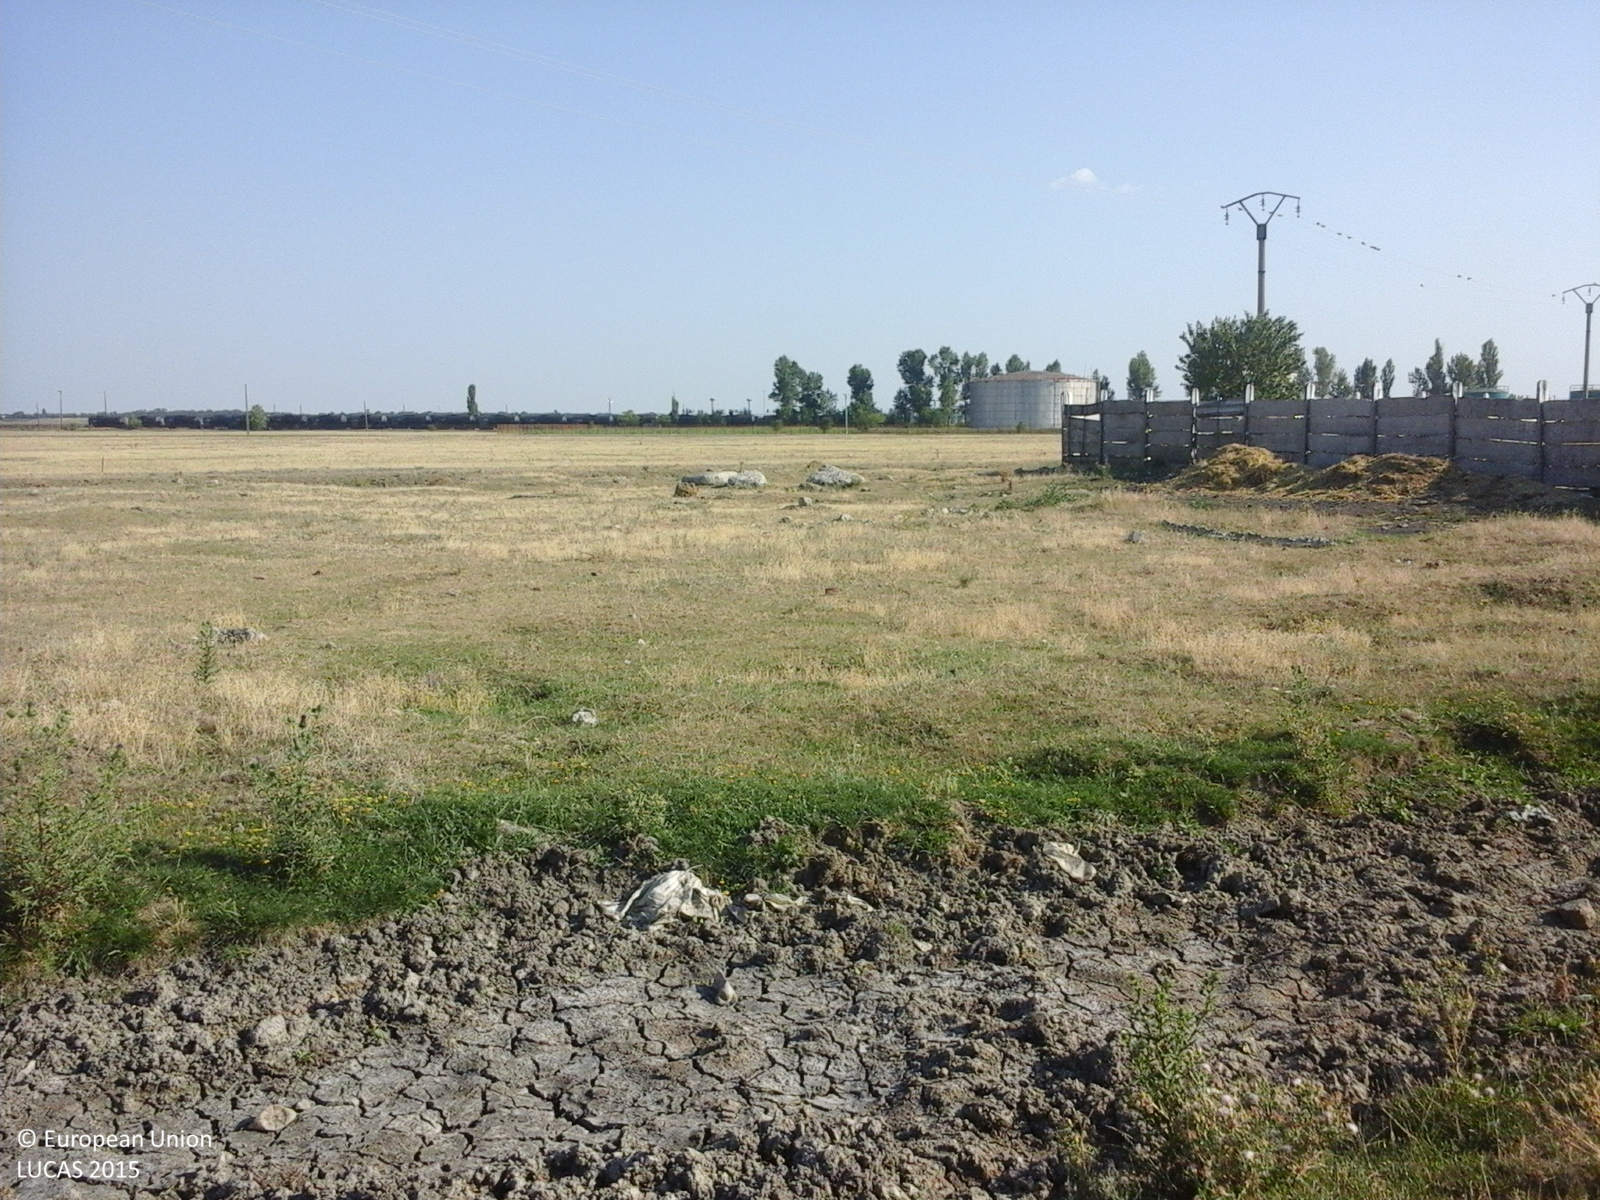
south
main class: Grassland
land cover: Spontaneously vegetated surfaces
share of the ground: > 75 %
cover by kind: herbaceous plants 100 %
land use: Agriculture (excluding fallow land and kitchen gardens)
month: July
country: RO
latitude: 44.9702
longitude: 27.3756
